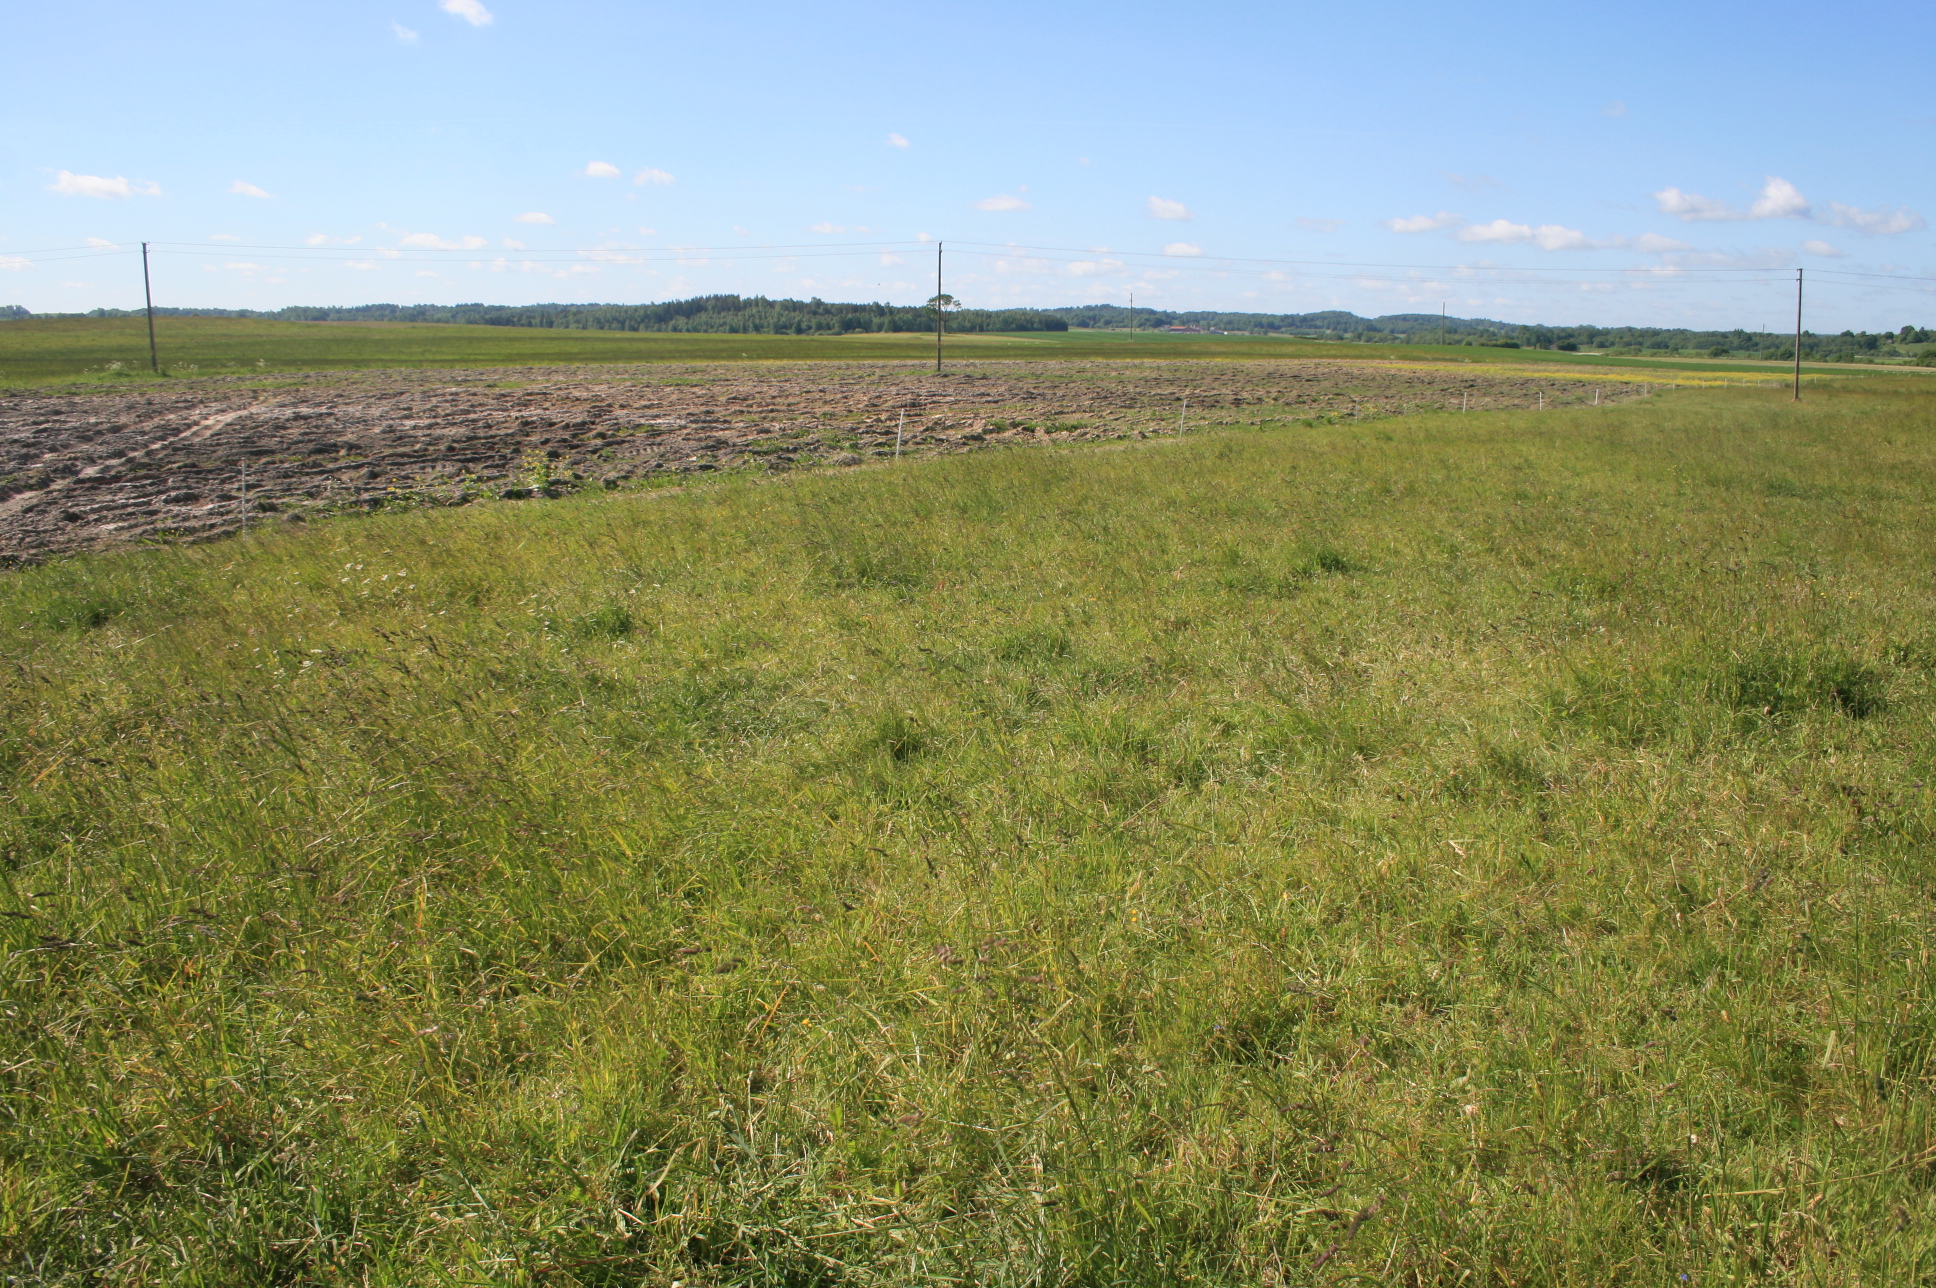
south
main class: Grassland
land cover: Grassland without tree/shrub cover
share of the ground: > 75 %
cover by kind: herbaceous plants 100 %
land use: Agriculture (excluding fallow land and kitchen gardens)
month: June
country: LT
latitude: 55.9420
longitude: 22.2719
